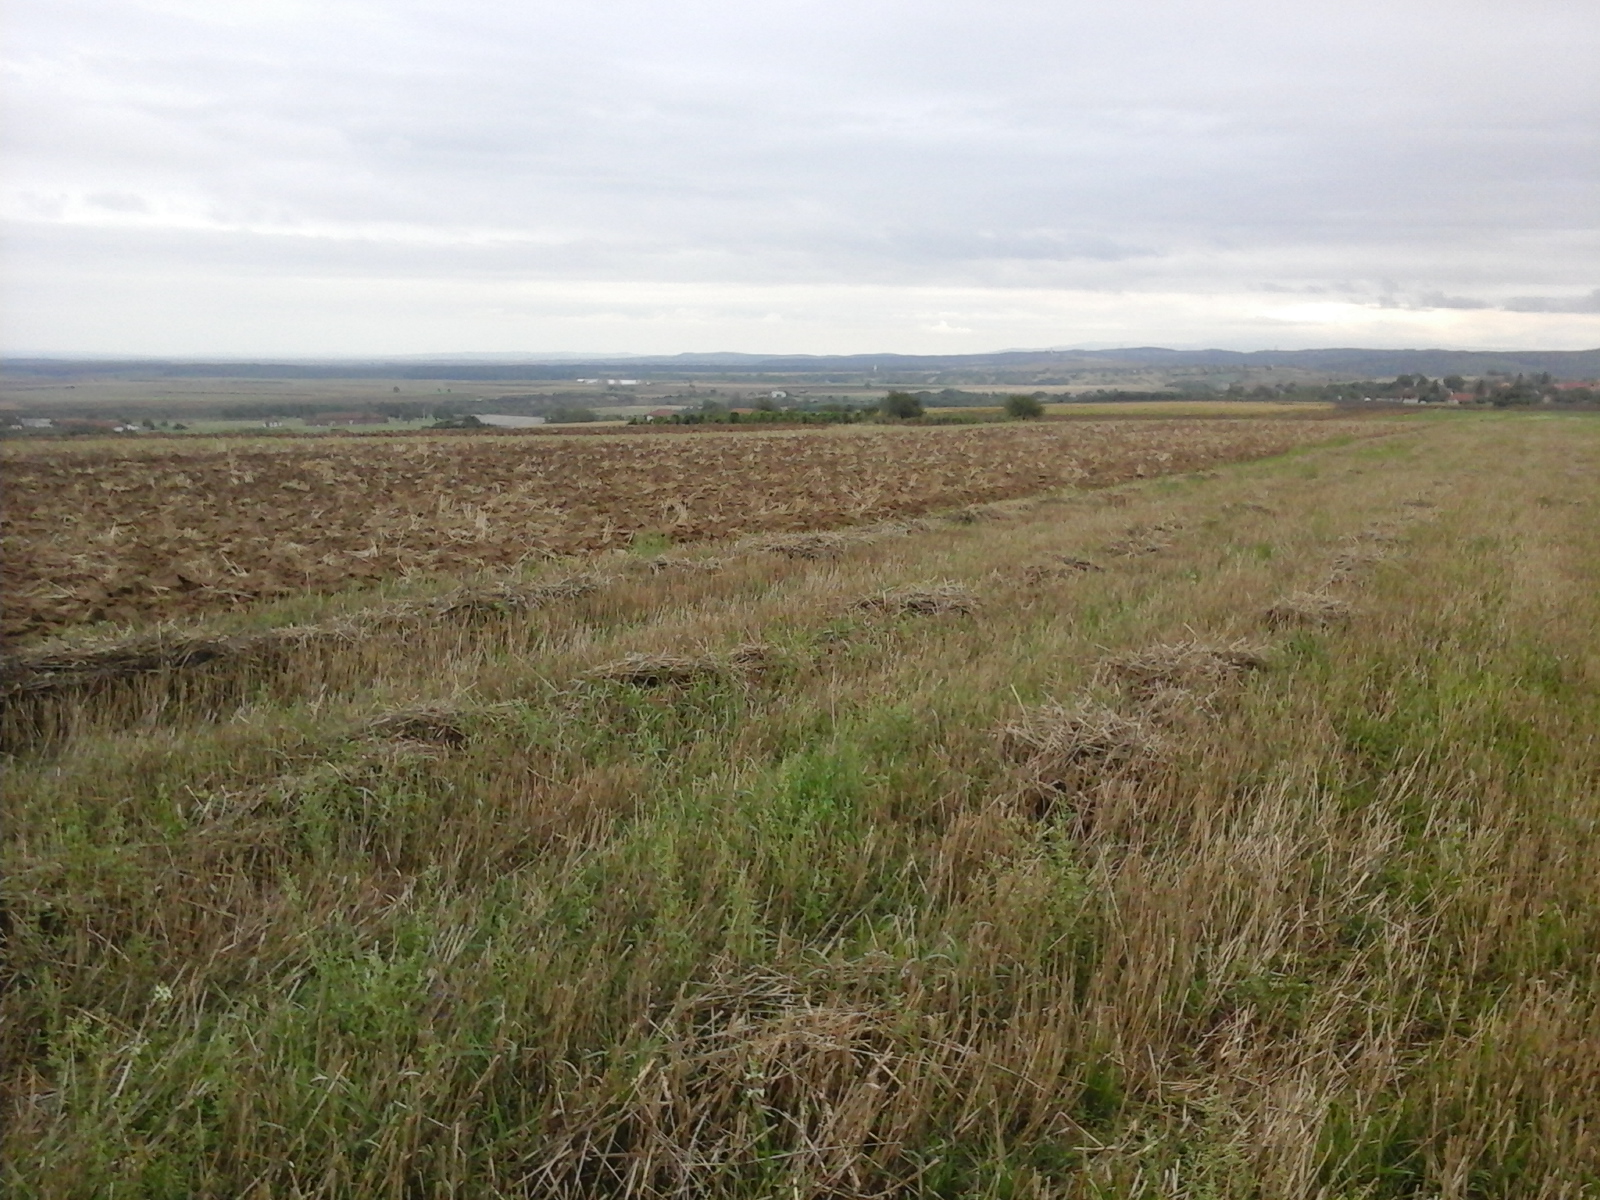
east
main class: Cropland
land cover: Common wheat
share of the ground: > 75 %
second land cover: Spontaneously vegetated surfaces
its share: 50 - 75 %
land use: Agriculture (excluding fallow land and kitchen gardens)
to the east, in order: Common wheat; Spontaneously vegetated surfaces
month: September
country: RO
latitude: 47.1489
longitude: 21.9825
